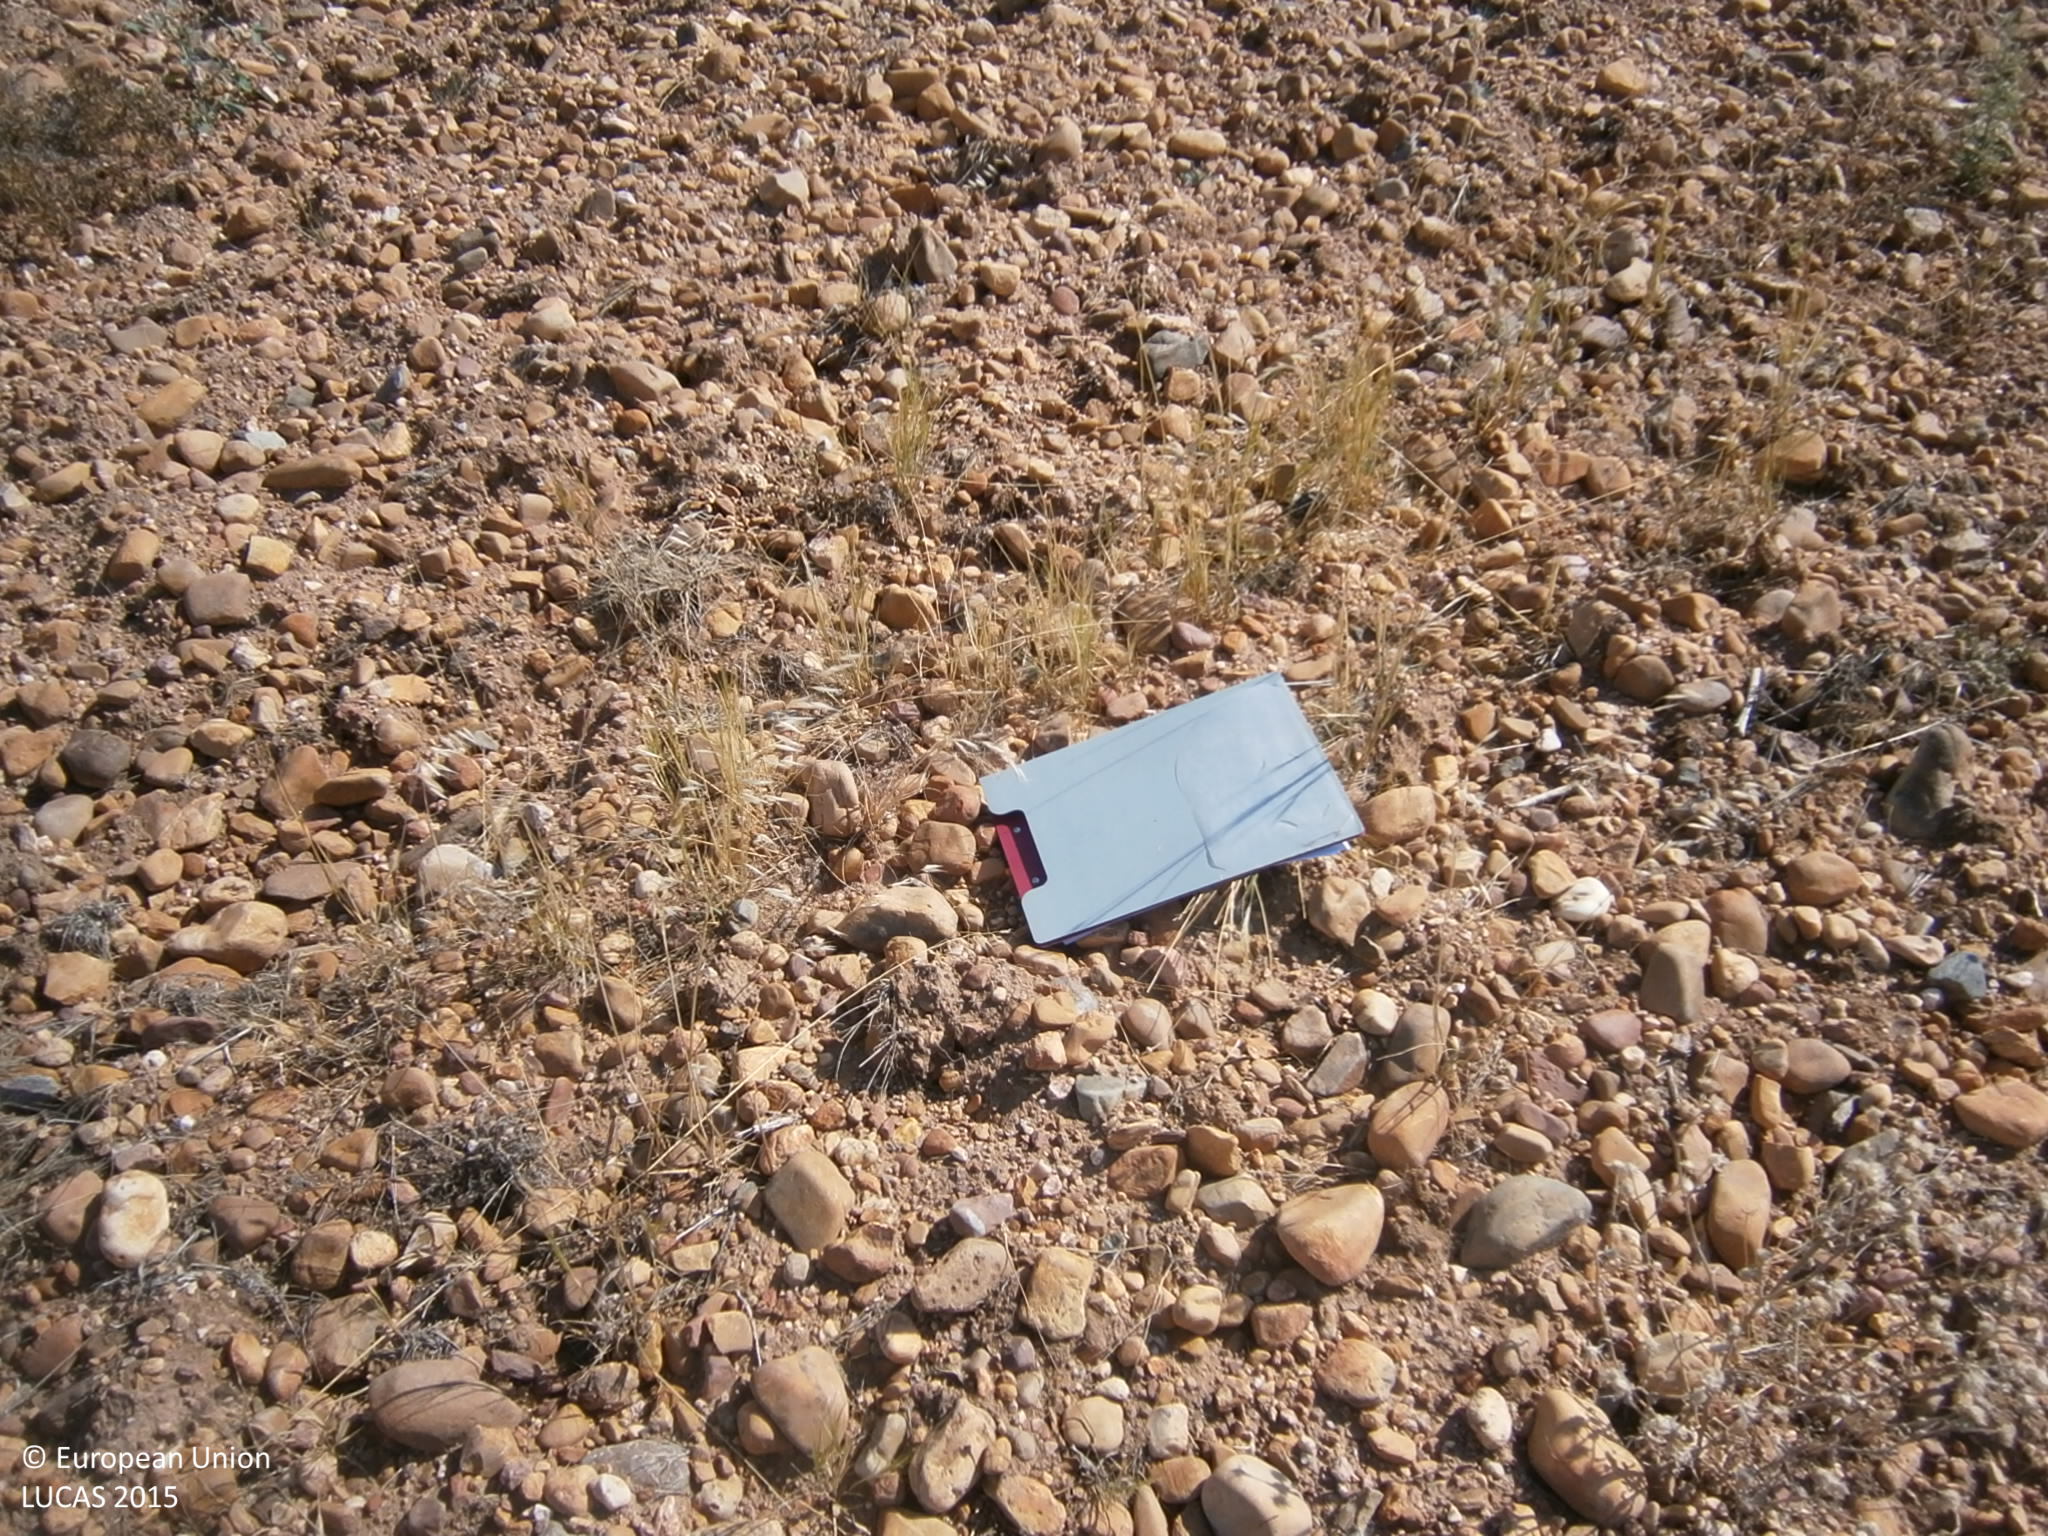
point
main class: Grassland
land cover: Spontaneously vegetated surfaces
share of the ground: 10 - 25 %
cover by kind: unconsolidated bare surface 85 %, herbaceous plants 15 %
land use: Fallow land
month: June
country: ES
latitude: 38.8427
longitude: -6.8060
